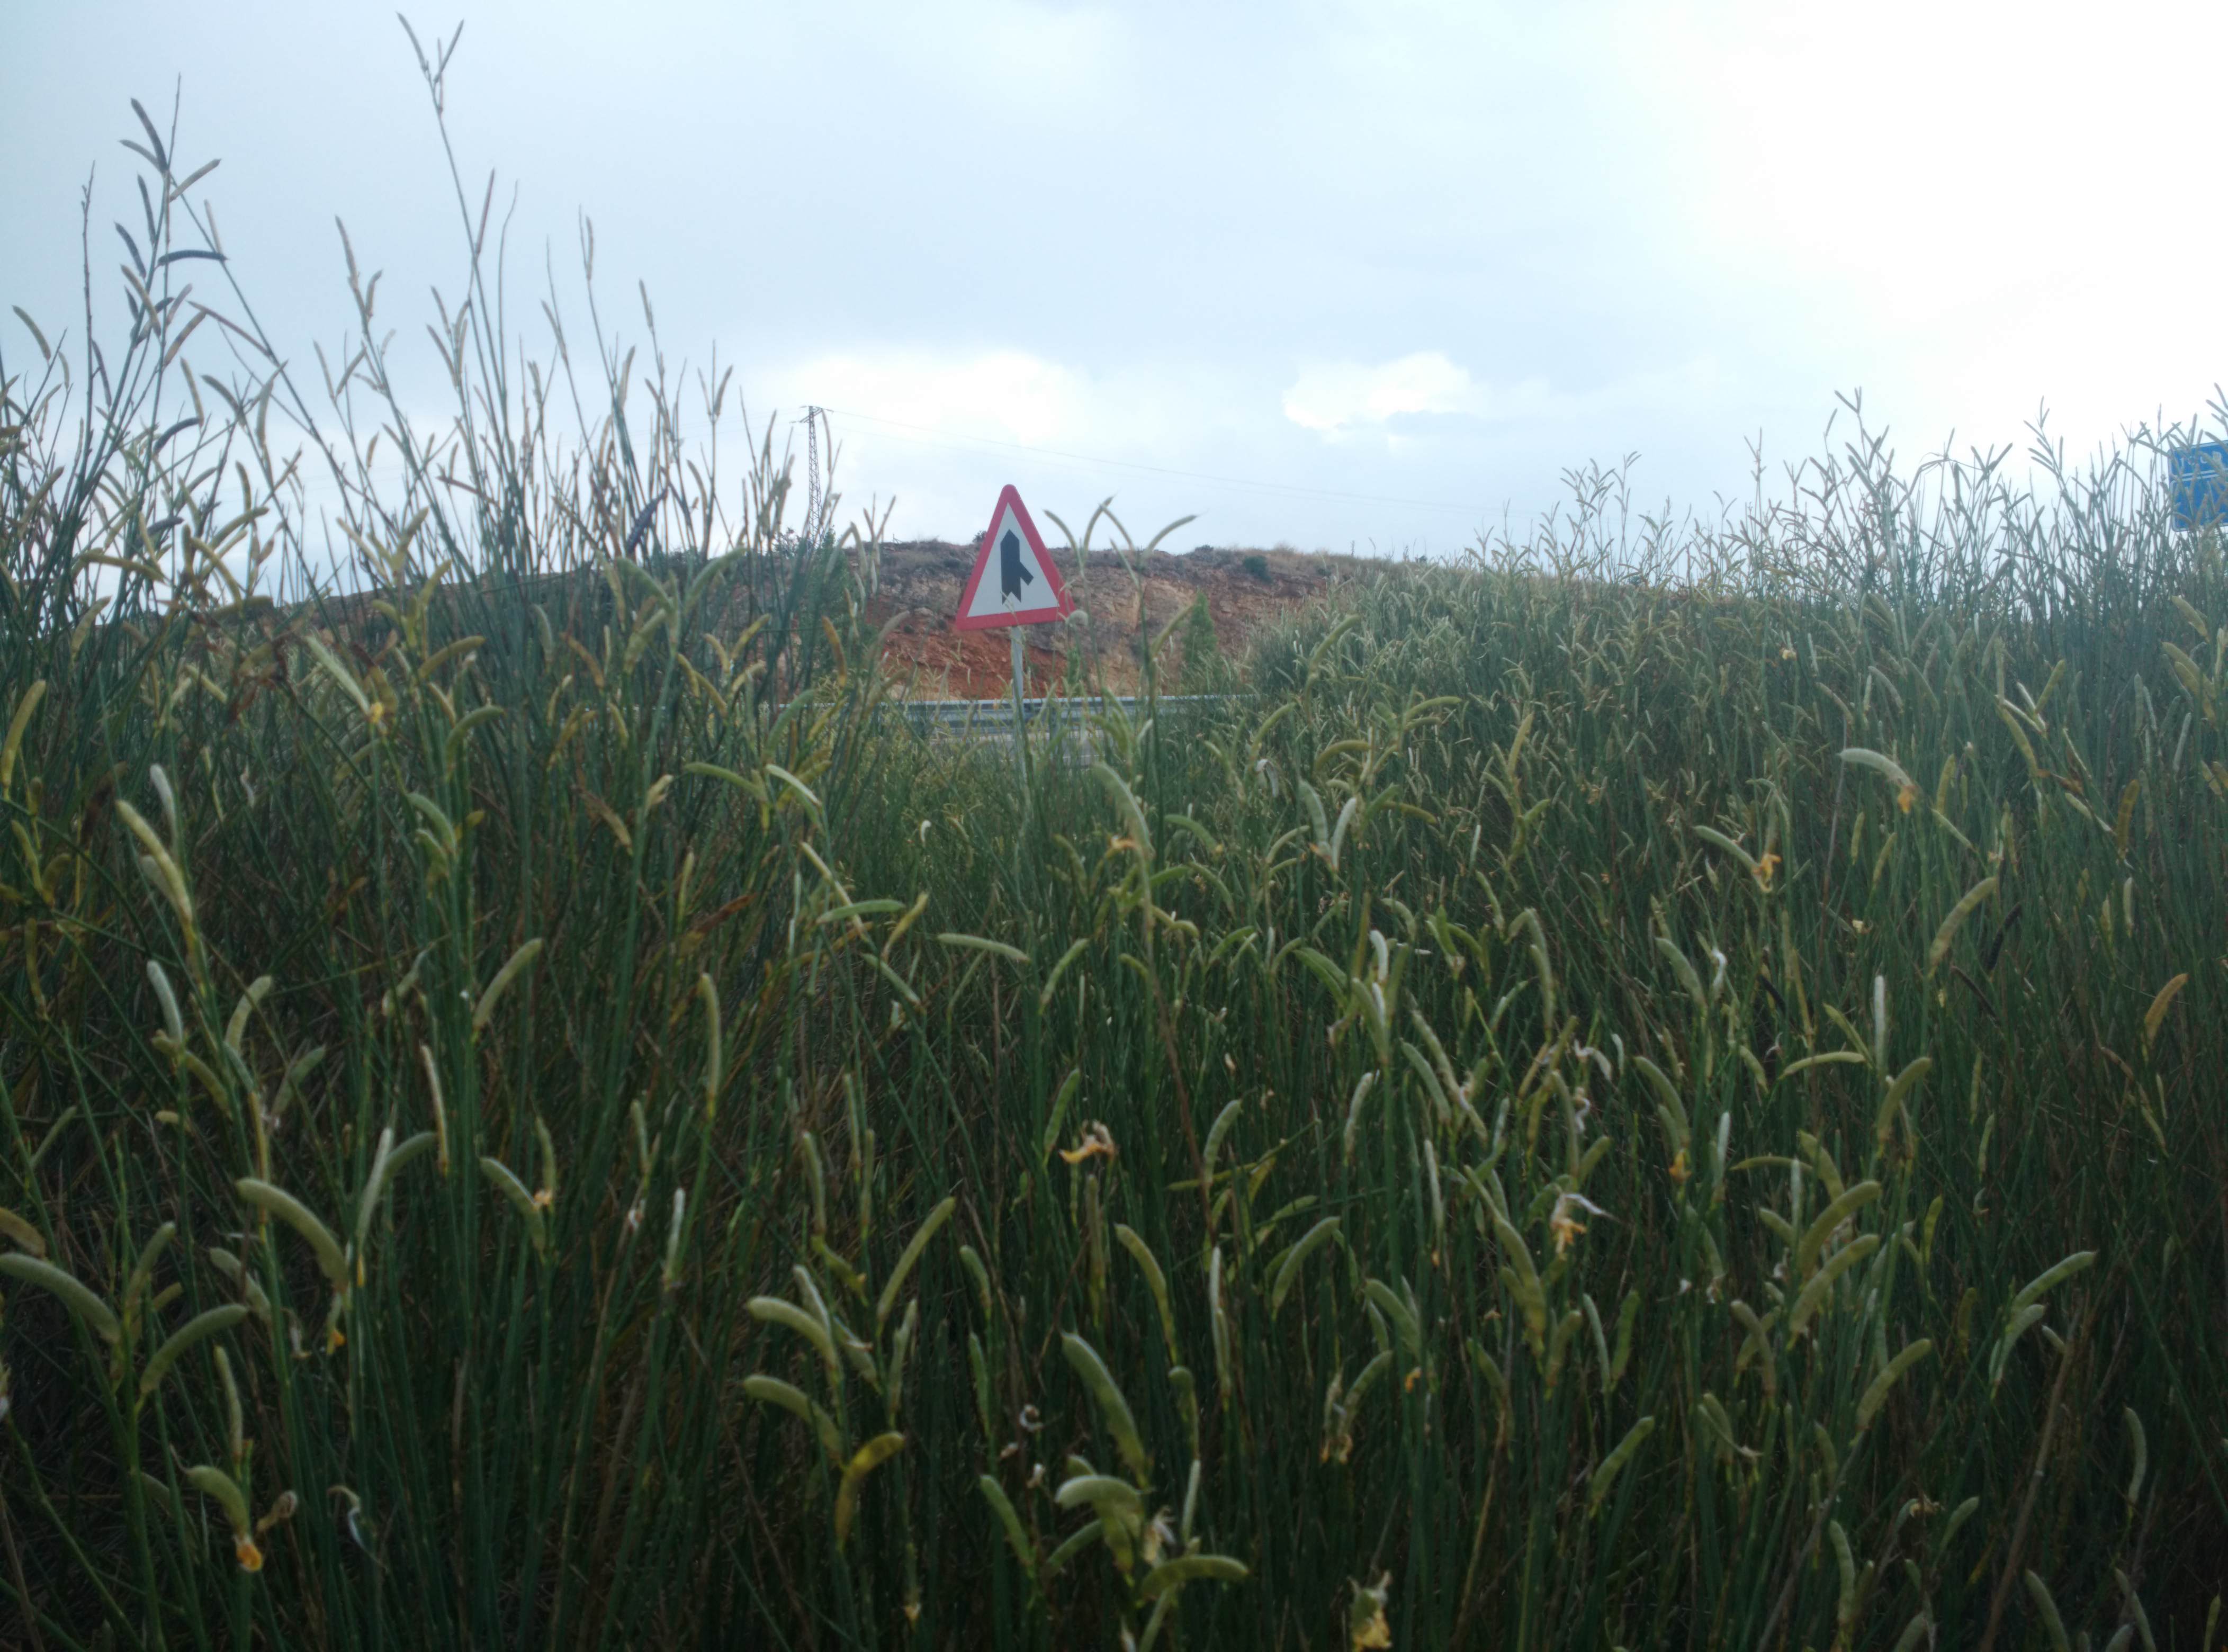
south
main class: Shrubland
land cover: Shrubland without tree cover
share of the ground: 50 - 75 %
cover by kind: shrubs 70 %, unconsolidated bare surface 30 %
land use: Semi-natural and natural areas not in use
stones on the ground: > 50 %
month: July
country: ES
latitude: 40.9639
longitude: -2.6380
